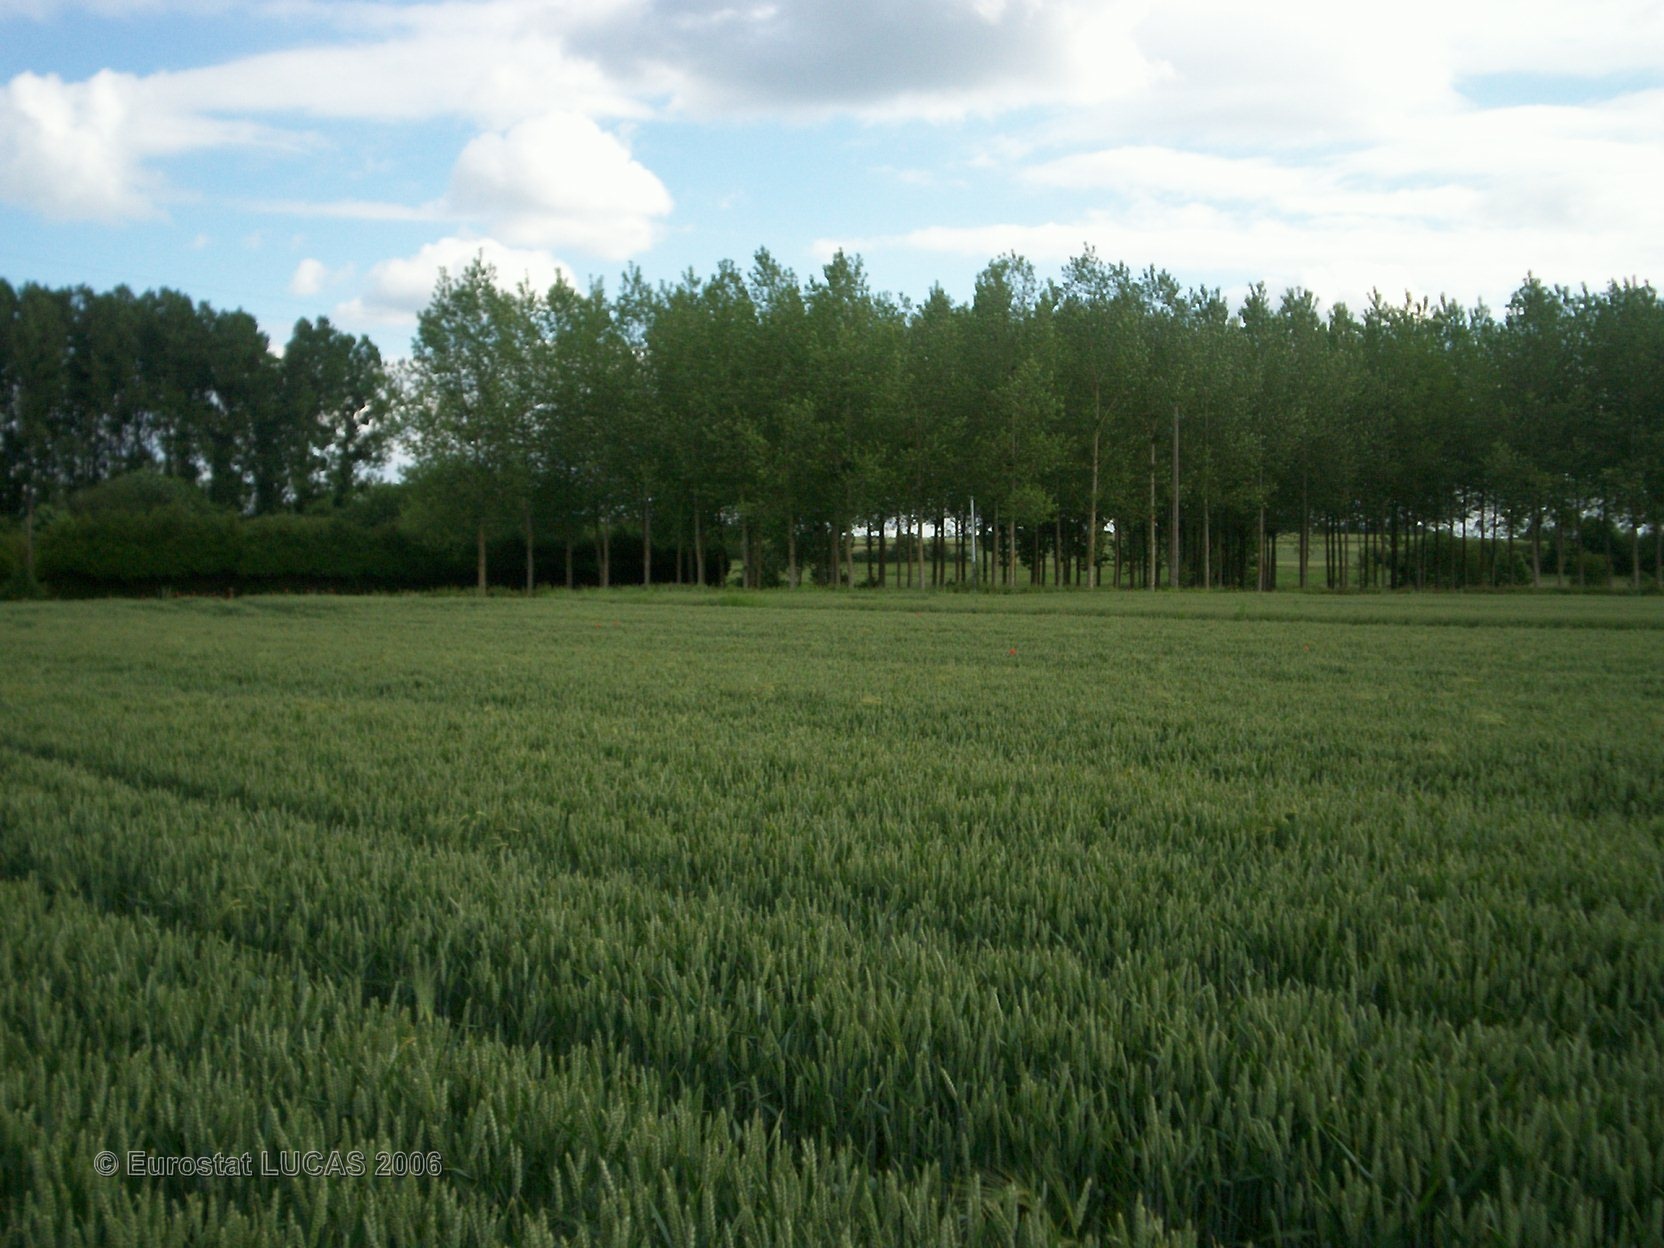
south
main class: Cropland
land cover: Common wheat
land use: Agriculture (excluding fallow land and kitchen gardens)
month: May
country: FR
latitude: 46.9926
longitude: 1.5331
